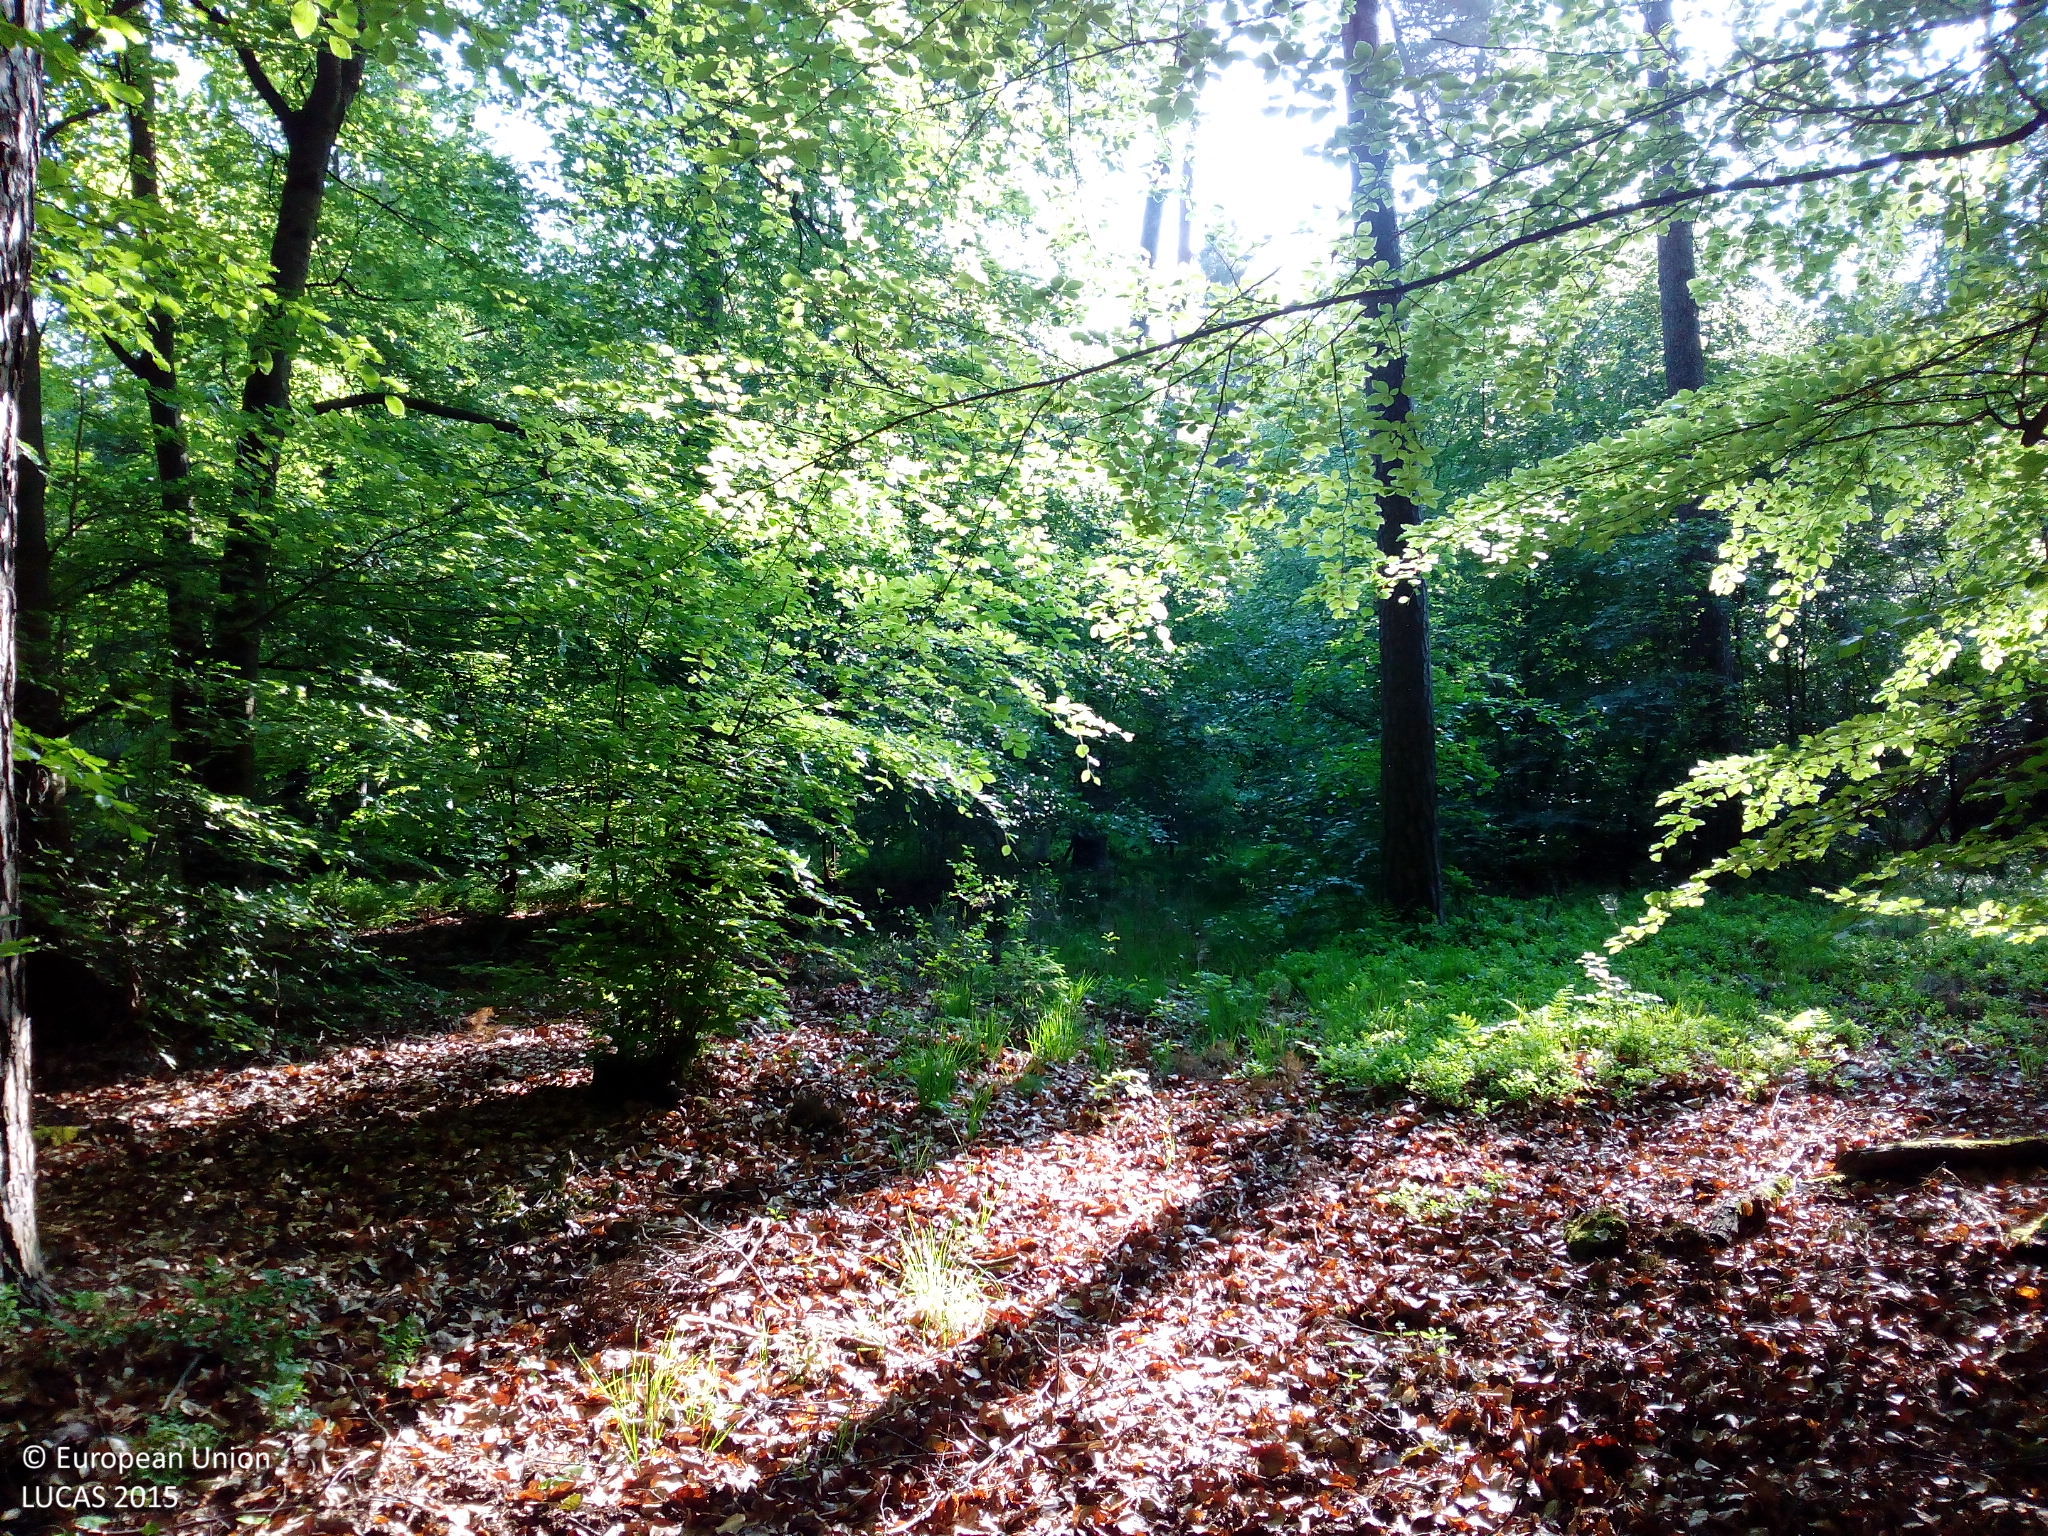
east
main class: Woodland
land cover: Other mixed woodland
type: hemiboreal forest and nemoral coniferous forest and mixed broadleaved-coniferous forest
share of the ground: > 75 %
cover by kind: broadleaved forest trees 60 %, coniferous forest trees 20 %, shrubs 10 %, herbaceous plants 5 %, unconsolidated bare surface 5 %
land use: Forestry
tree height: > 5 m
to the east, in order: Other mixed woodland; Ditches and canals; Paved roads, cycling and walking lanes; Ditches and canals; Other mixed woodland
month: May
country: DE
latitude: 49.0544
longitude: 8.1807
